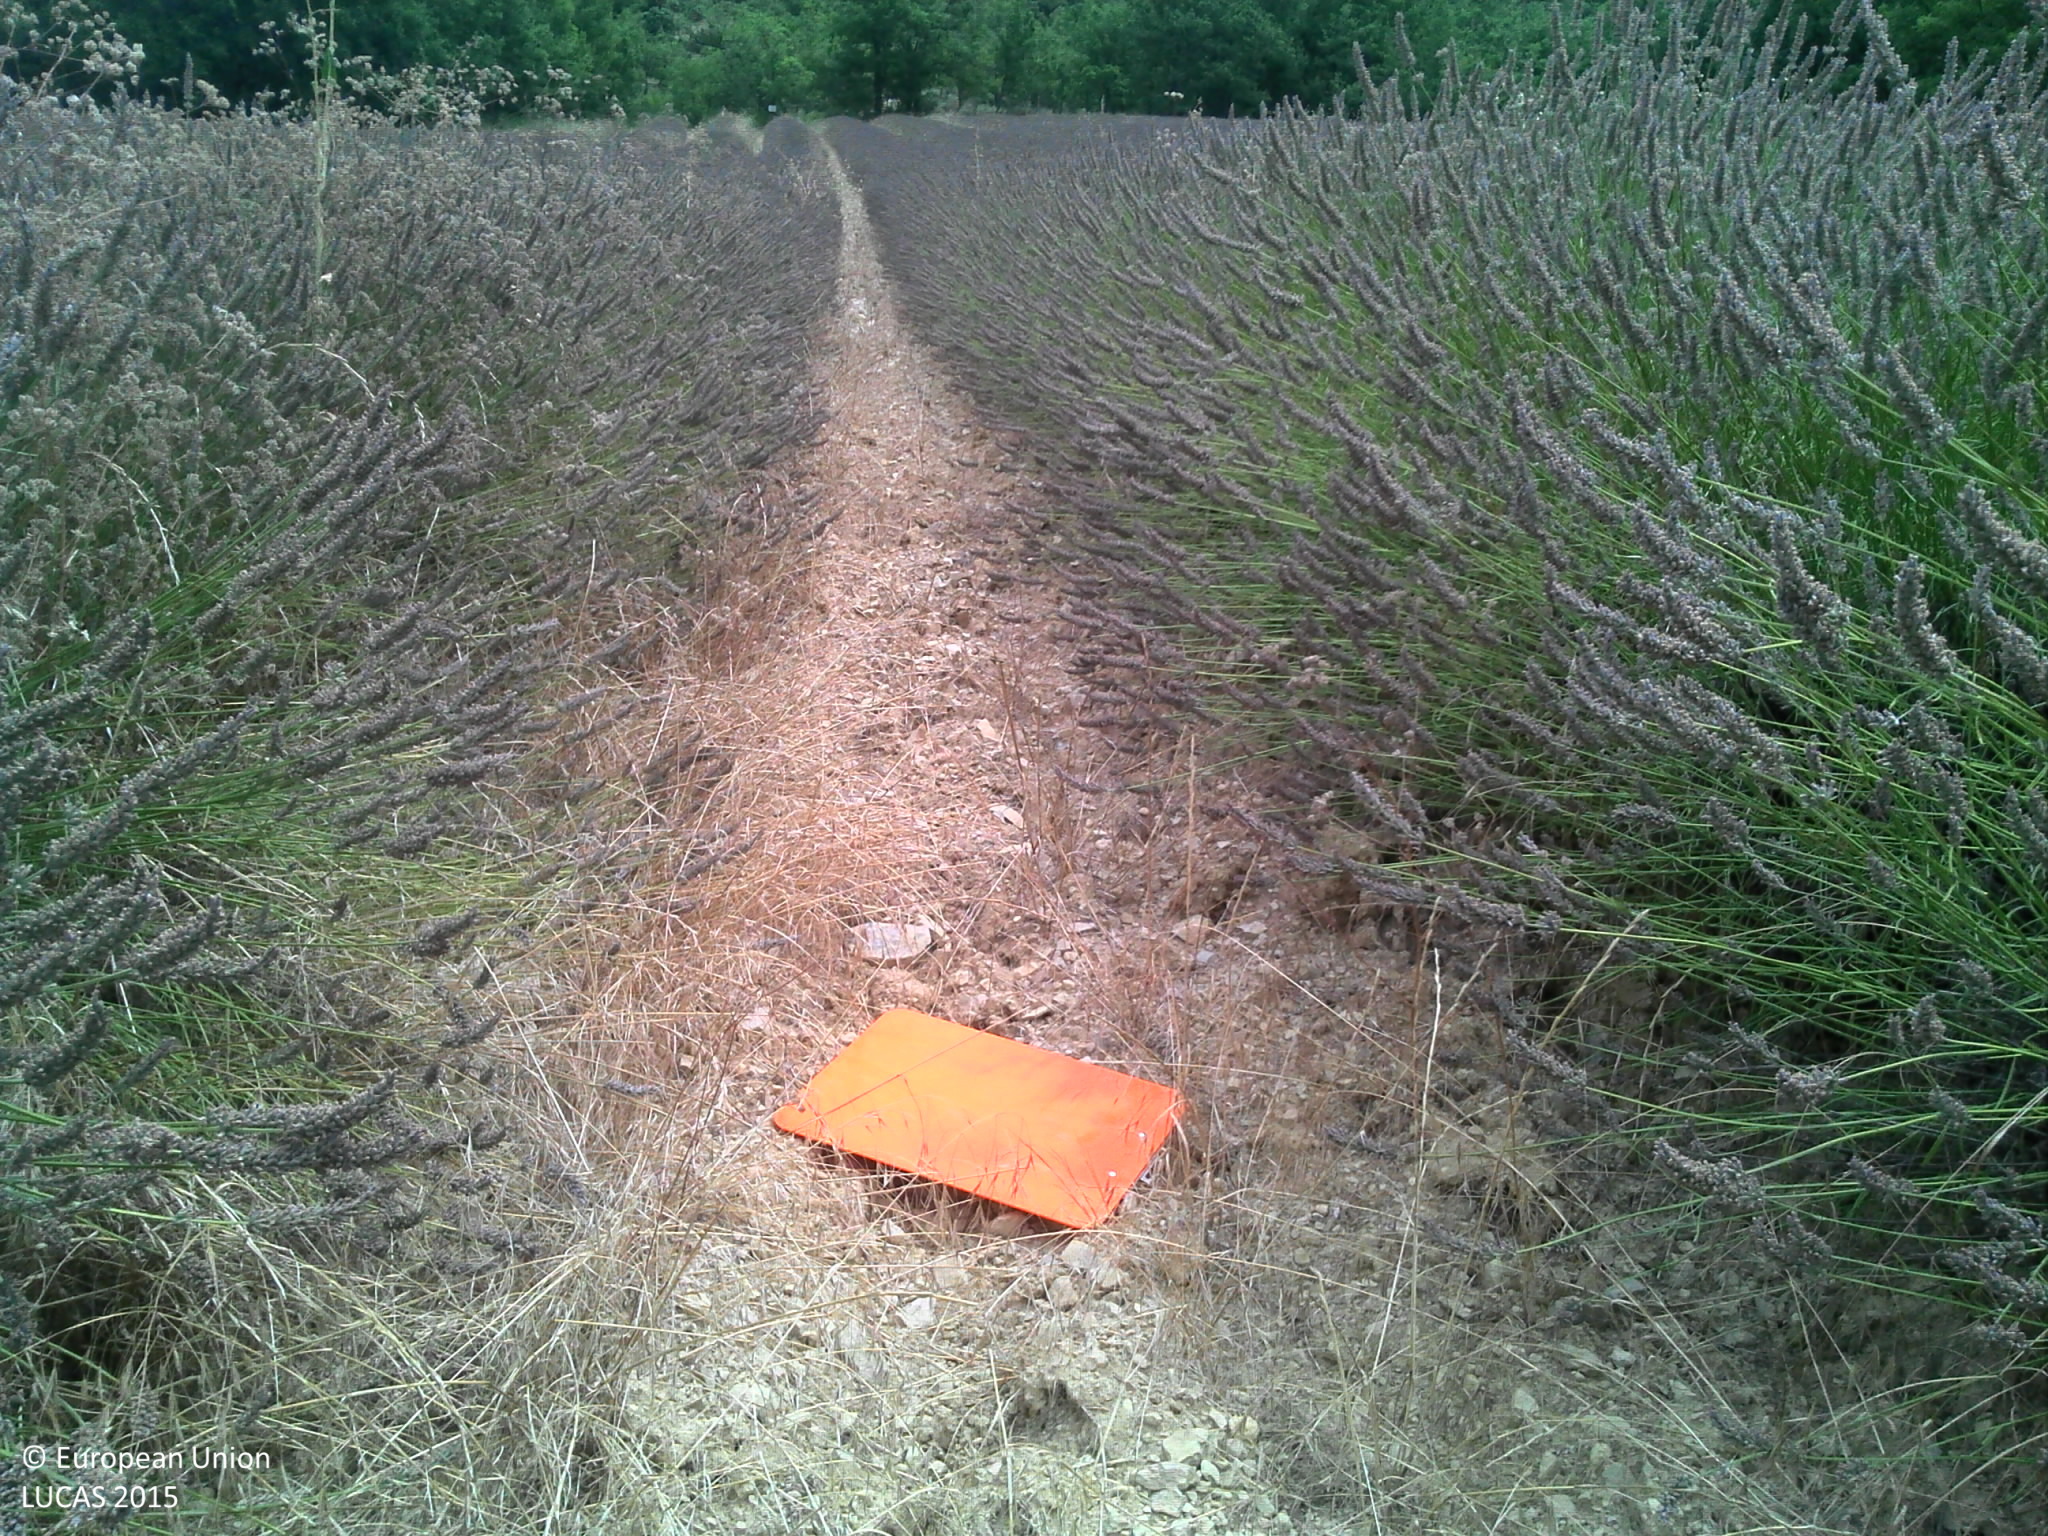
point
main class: Cropland
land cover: Floriculture and ornamental plants
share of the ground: > 75 %
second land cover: Spontaneously vegetated surfaces
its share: 50 - 75 %
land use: Agriculture (excluding fallow land and kitchen gardens)
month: July
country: FR
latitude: 44.5164
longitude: 4.5845
